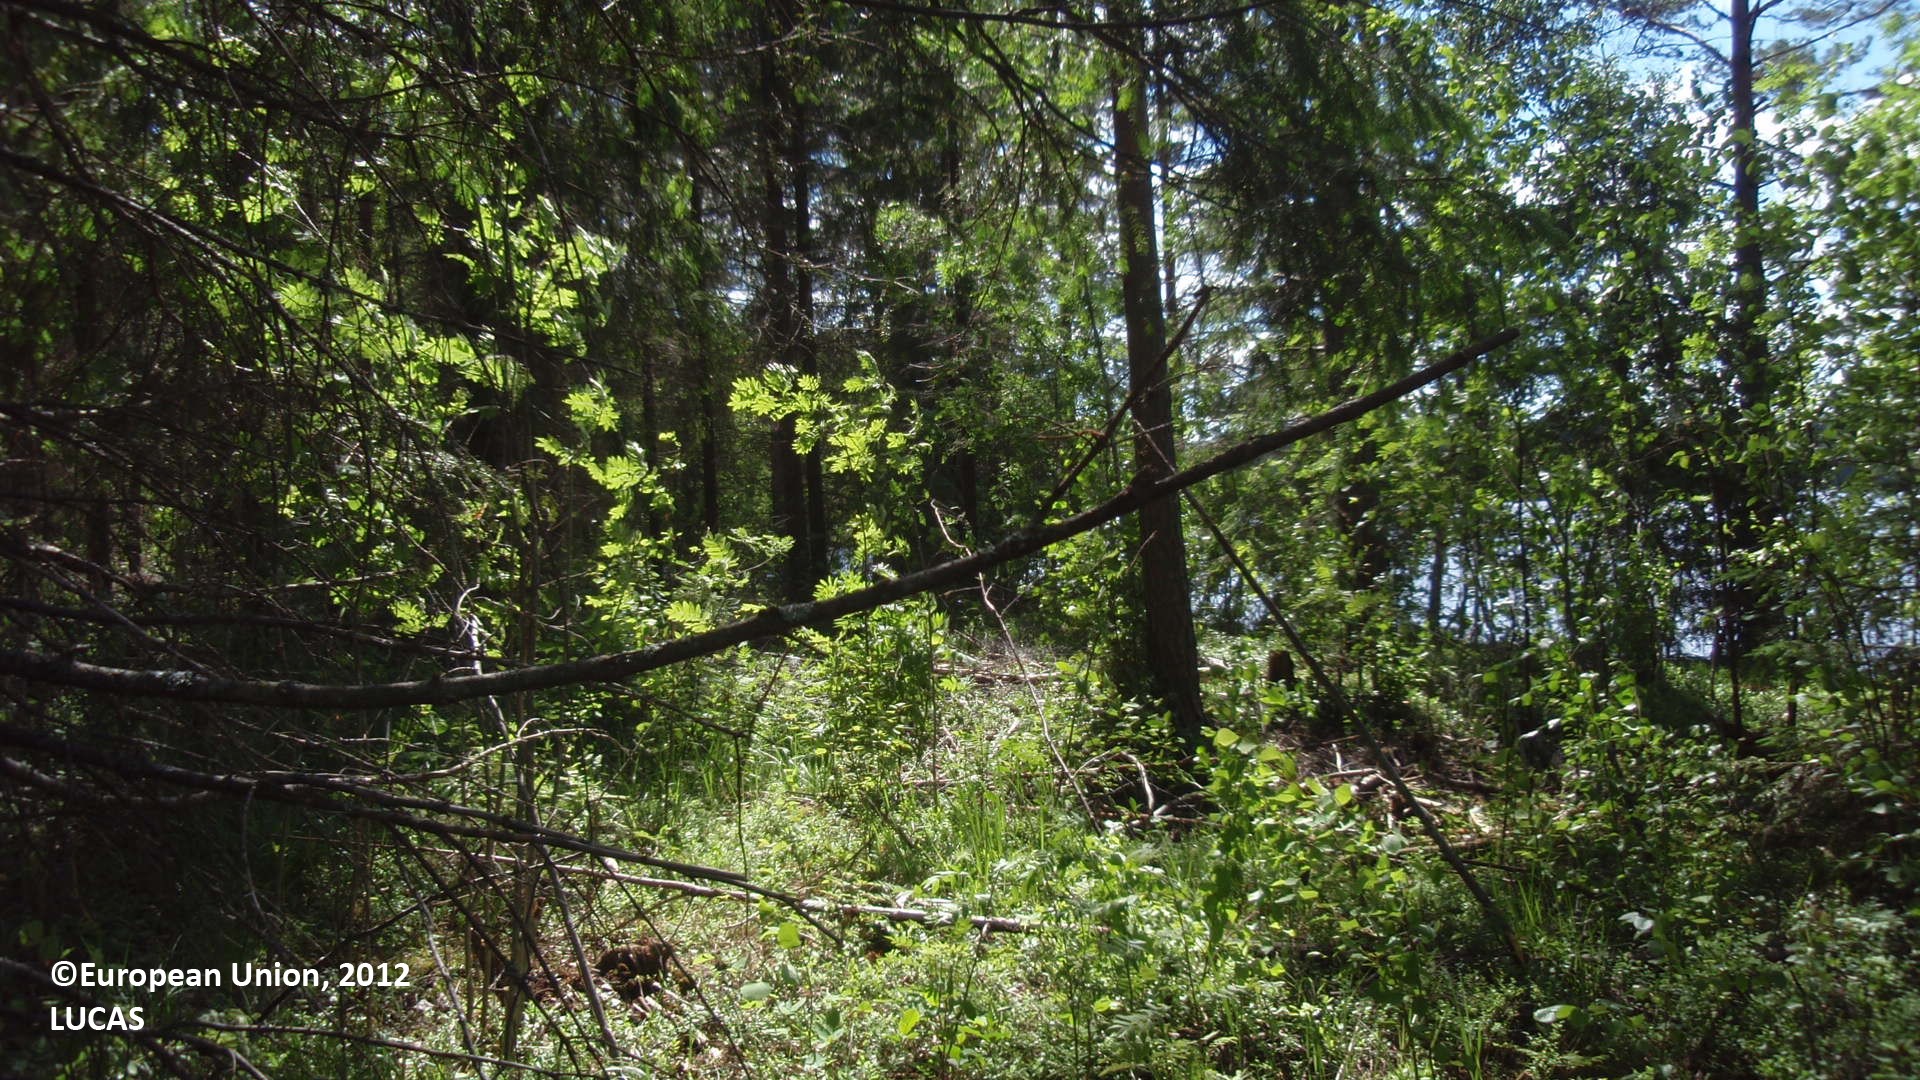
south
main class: Woodland
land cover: Spruce dominated mixed woodland
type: boreal forest
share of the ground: 50 - 75 %
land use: Forestry
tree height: > 5 m
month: June
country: FI
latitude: 61.5974
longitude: 26.6792
